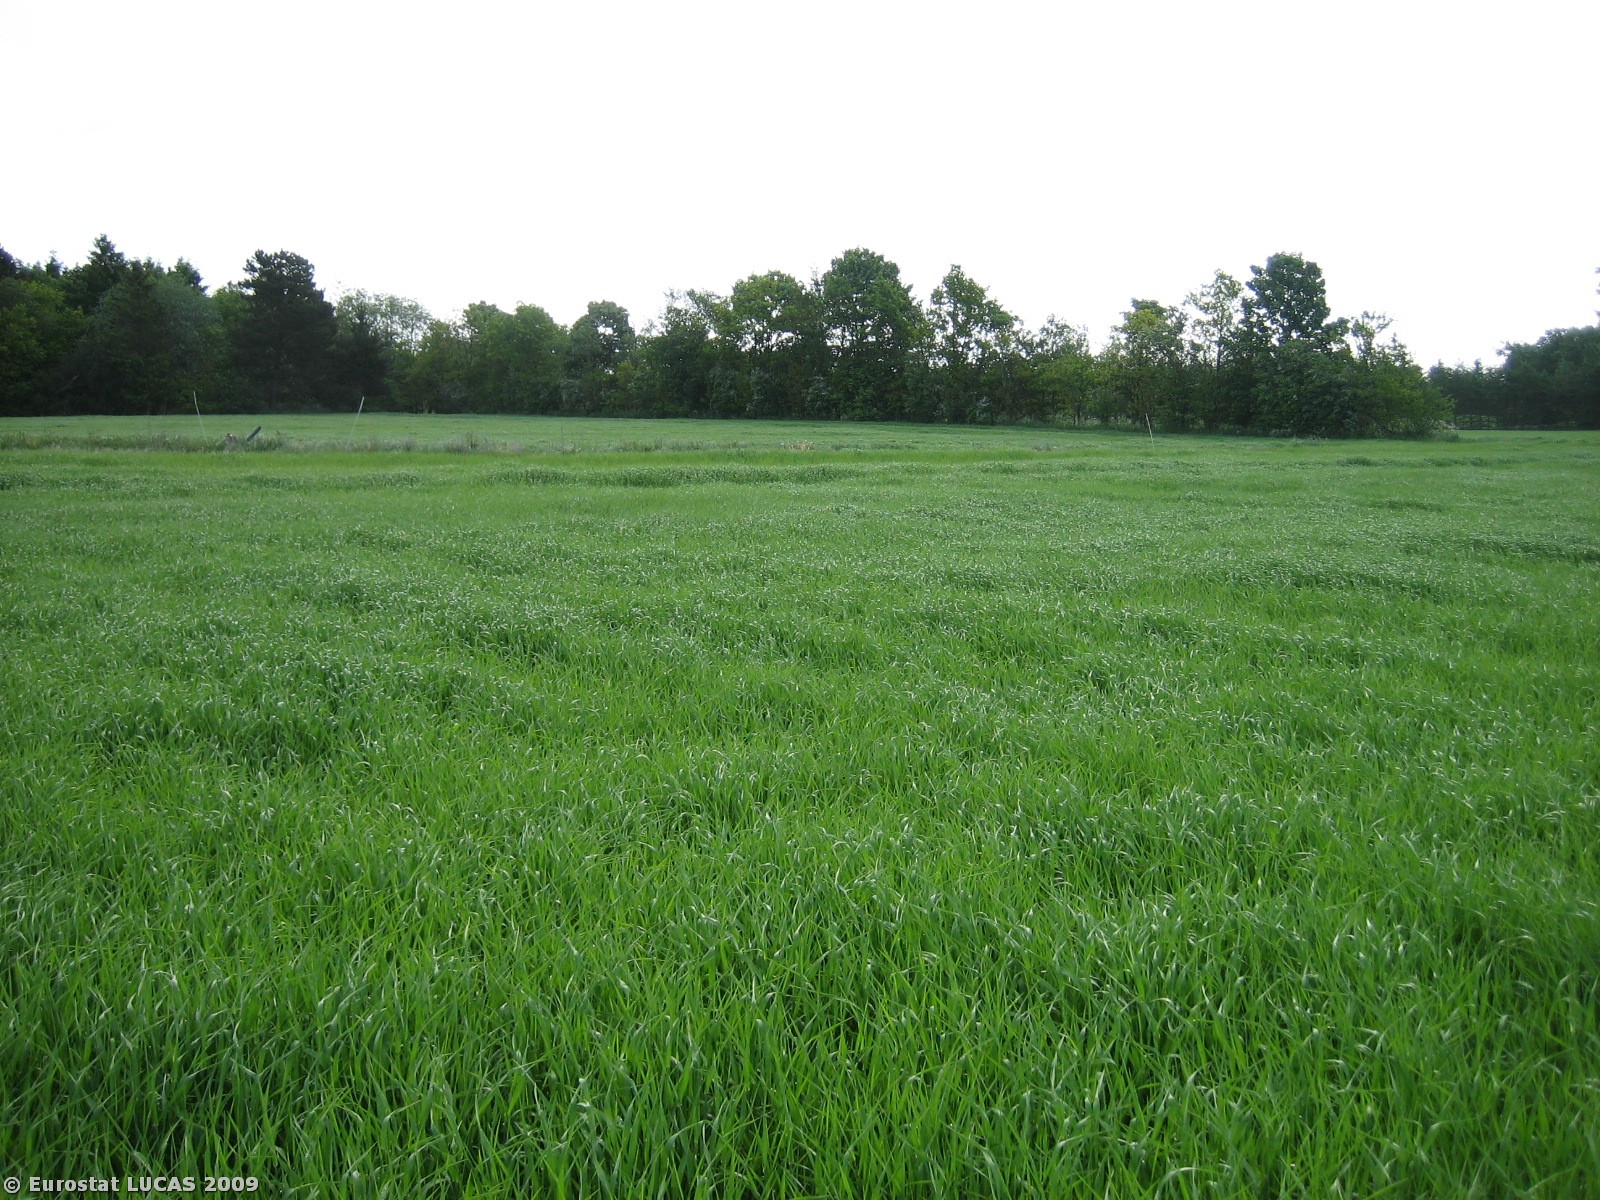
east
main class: Cropland
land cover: Barley
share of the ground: > 75 %
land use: Agriculture (excluding fallow land and kitchen gardens)
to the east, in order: Barley; Grass margins; Tracks; Barley; Broadleaved woodland; Barley; Abandoned hedges
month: May
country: DK
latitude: 55.8977
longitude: 9.2172
